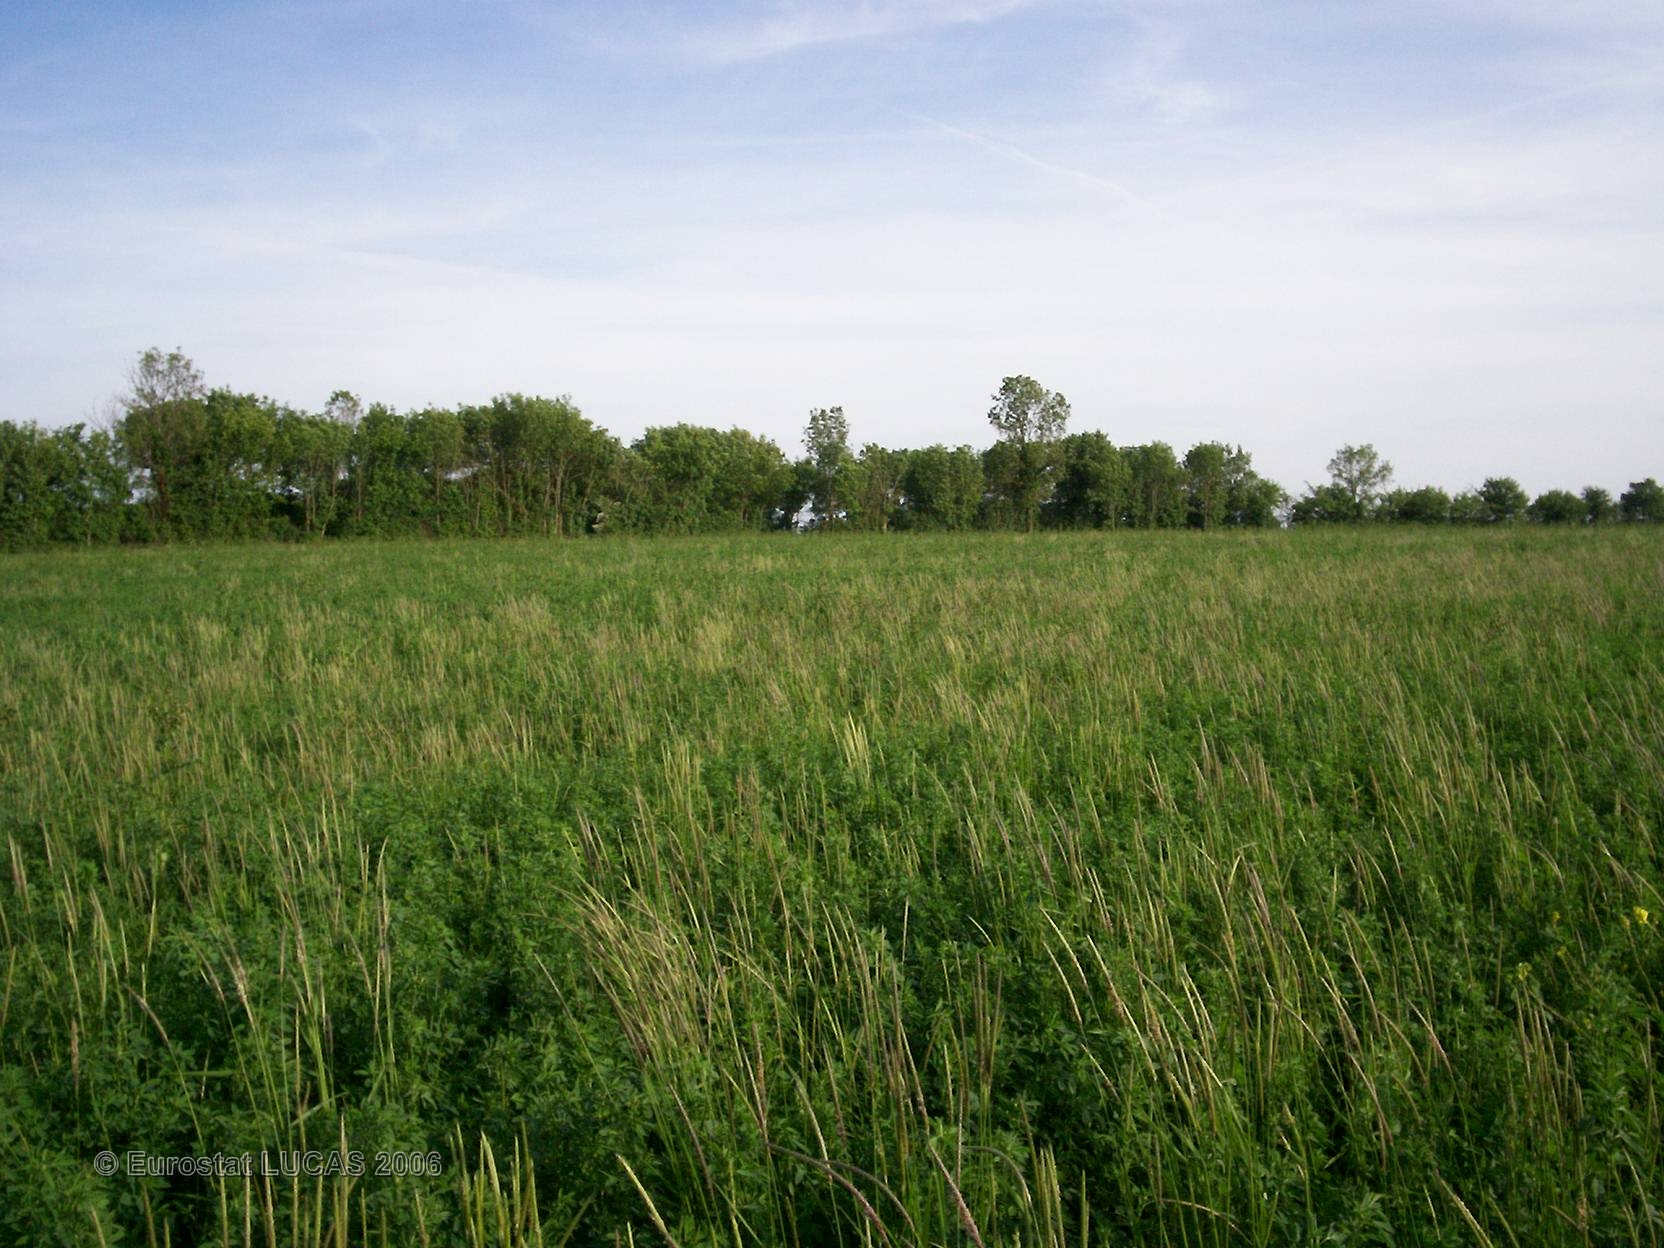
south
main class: Cropland
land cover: Lucerne
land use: Agriculture (excluding fallow land and kitchen gardens)
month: May
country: FR
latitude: 46.1540
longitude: -0.1863
